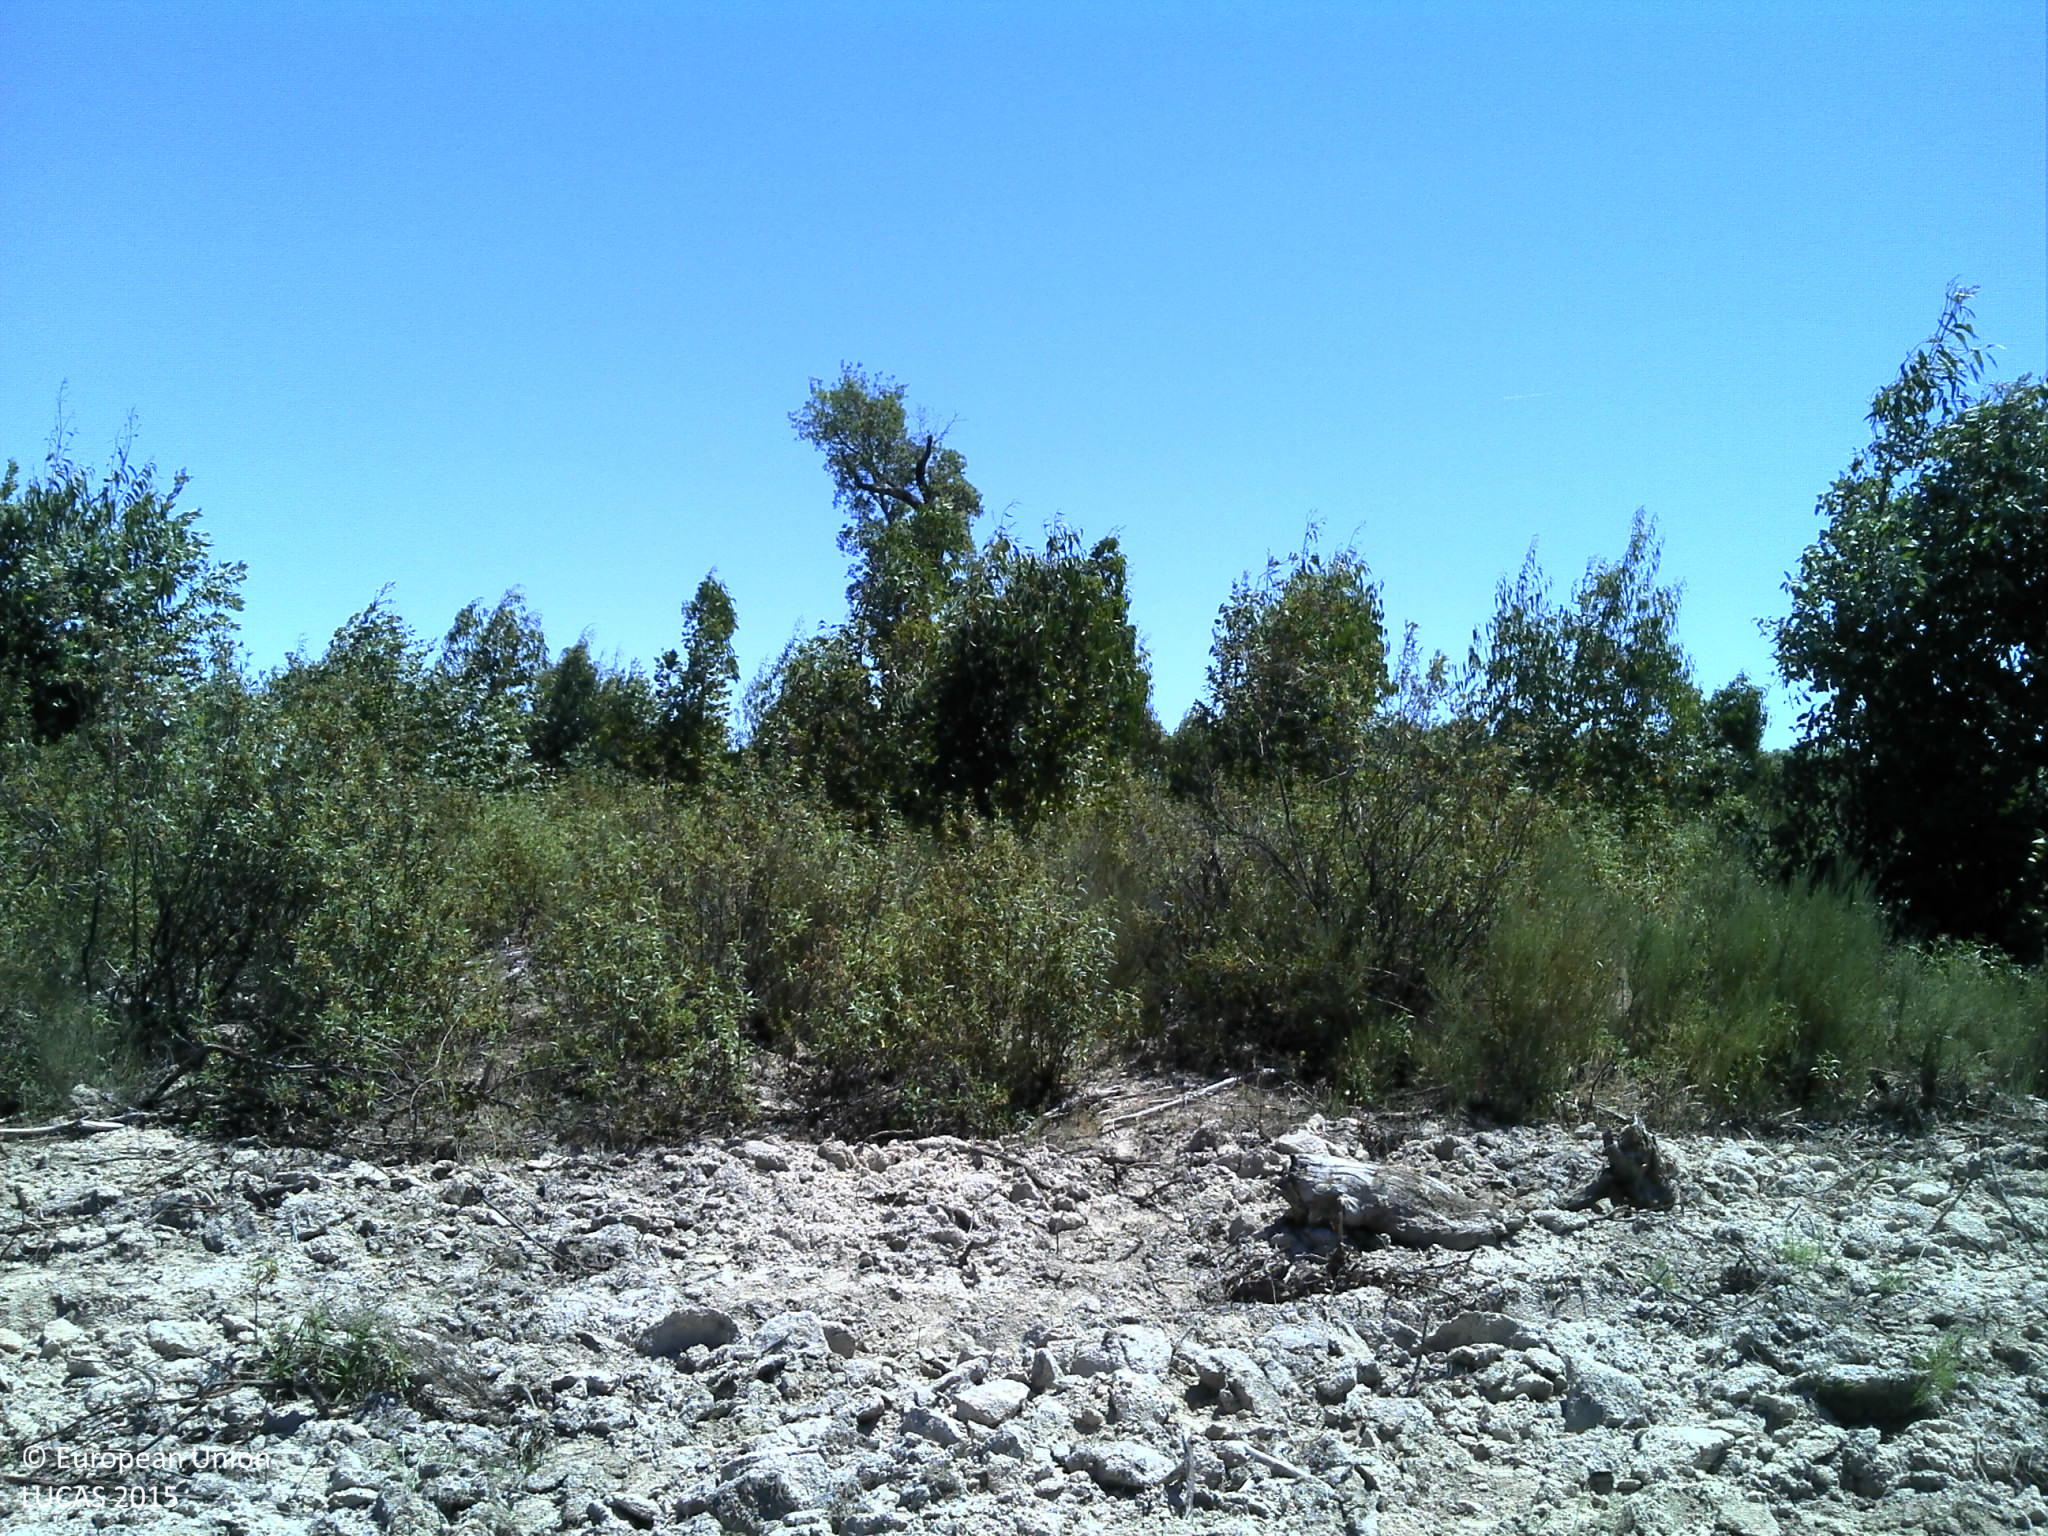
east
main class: Woodland
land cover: Broadleaved woodland
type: exotic forest
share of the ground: 10 - 25 %
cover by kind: unconsolidated bare surface 90 %, broadleaved forest trees 10 %
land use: Forestry
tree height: > 5 m
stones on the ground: < 10 %
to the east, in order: Broadleaved woodland; Other bare soil; Broadleaved woodland; Fences; Broadleaved woodland; Other bare soil; Fences; Dry stone walls; Broadleaved woodland
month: May
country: PT
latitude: 39.4554
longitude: -7.7041
